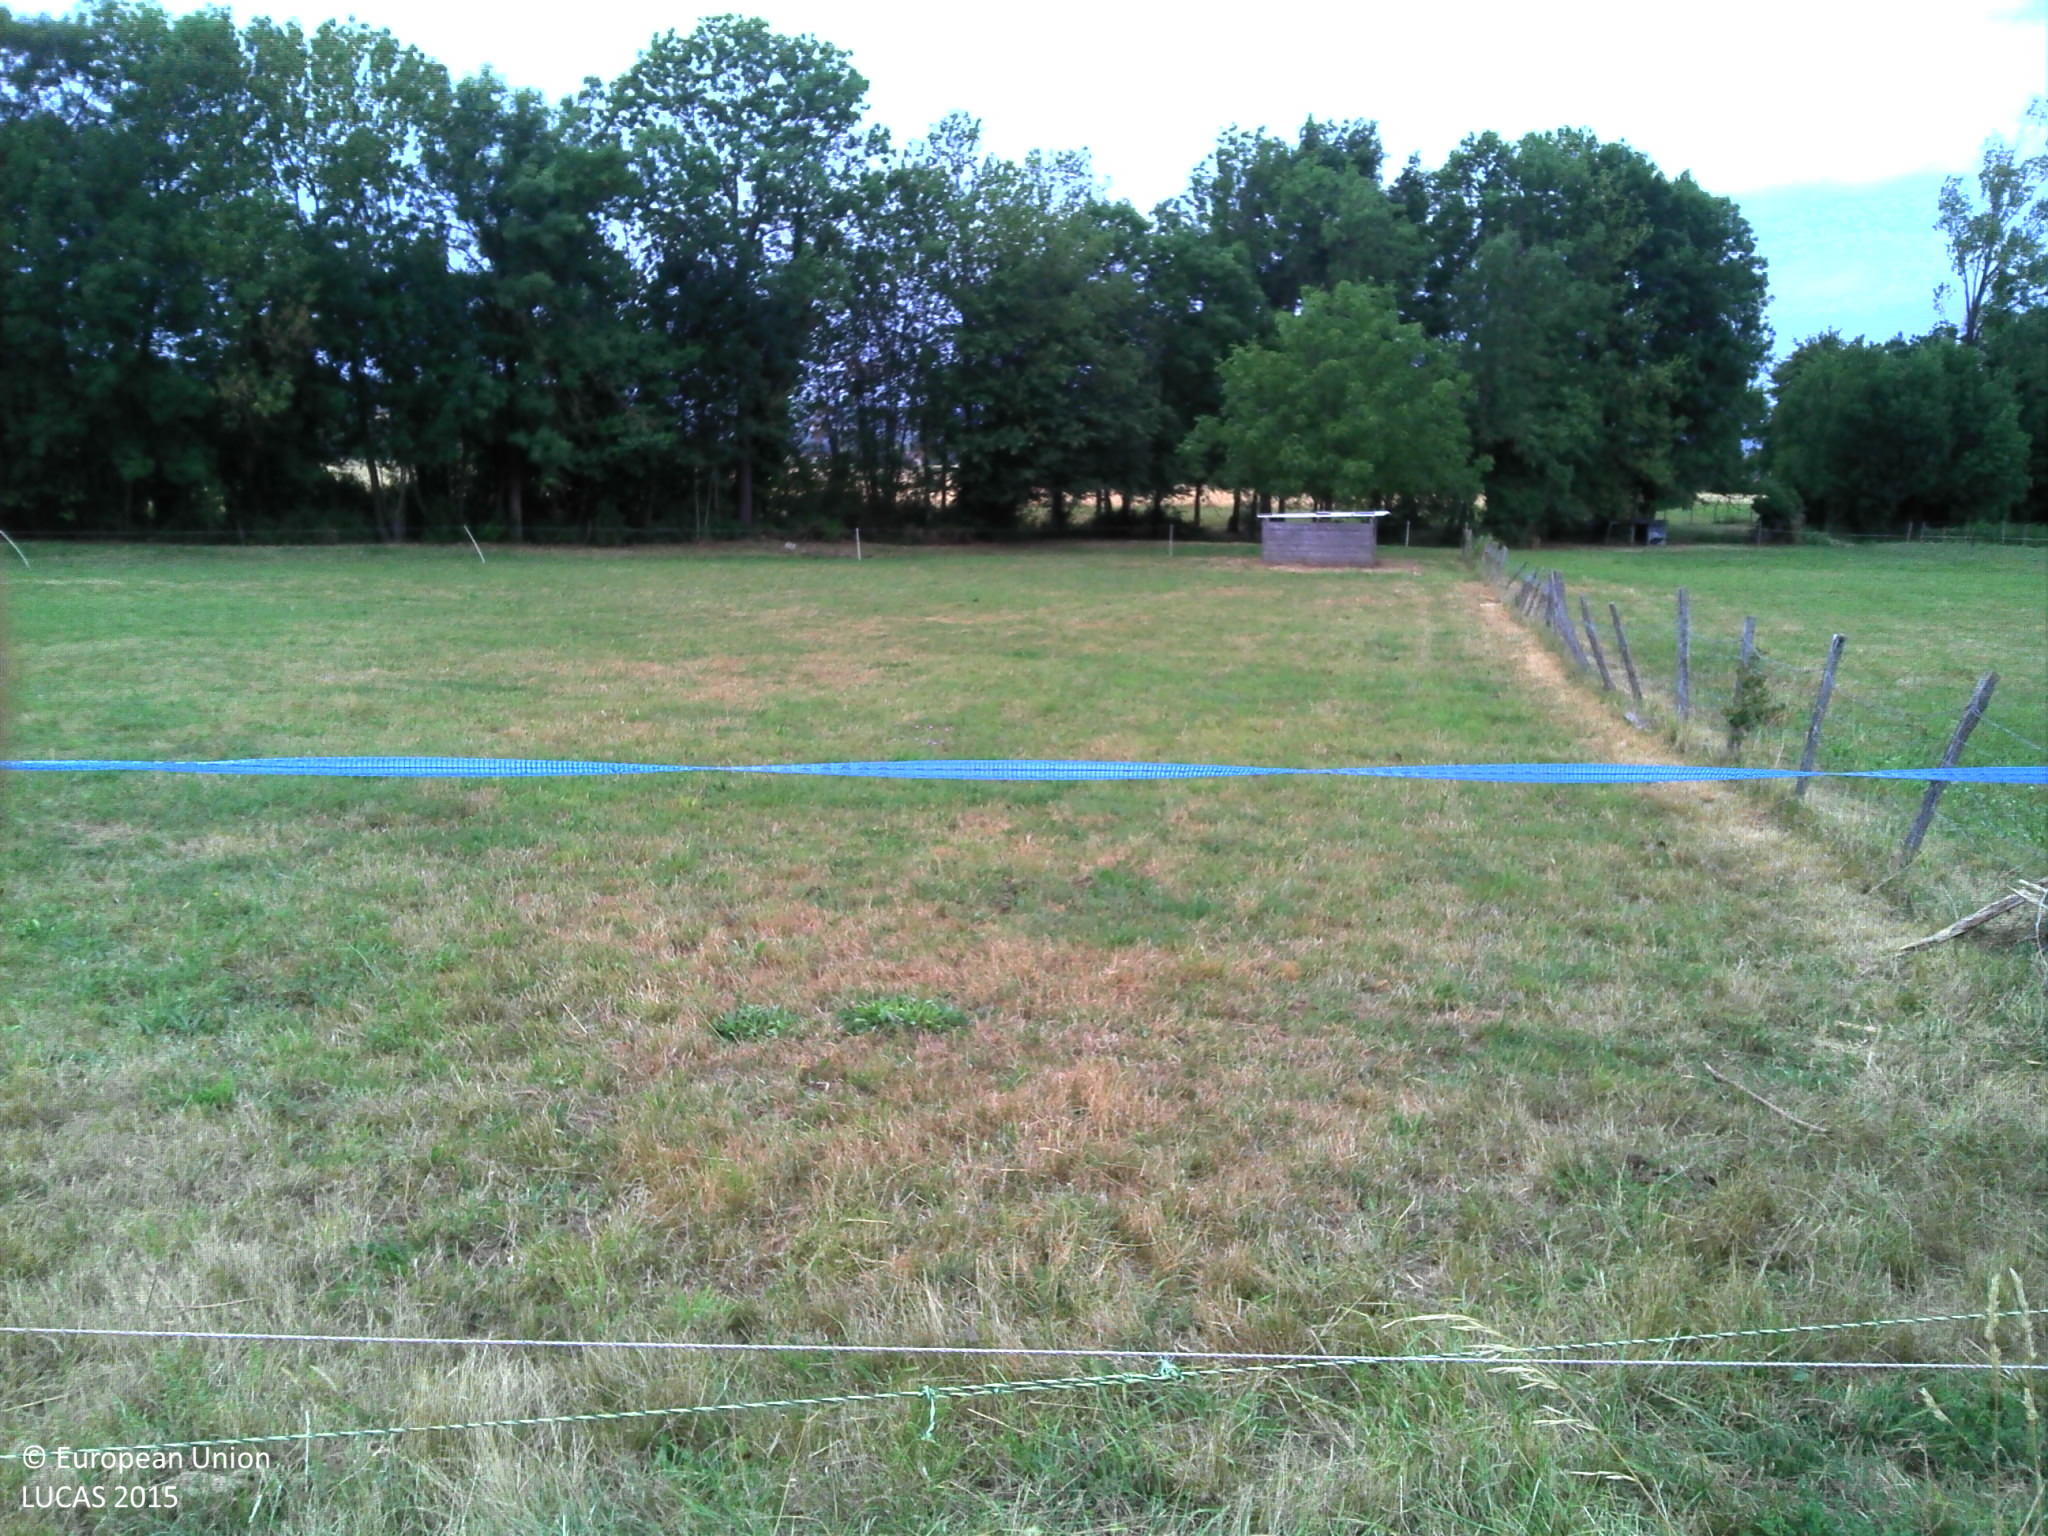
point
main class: Grassland
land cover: Grassland without tree/shrub cover
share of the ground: > 75 %
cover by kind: herbaceous plants 100 %
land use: Agriculture (excluding fallow land and kitchen gardens)
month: July
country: FR
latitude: 45.4751
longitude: 4.9771
